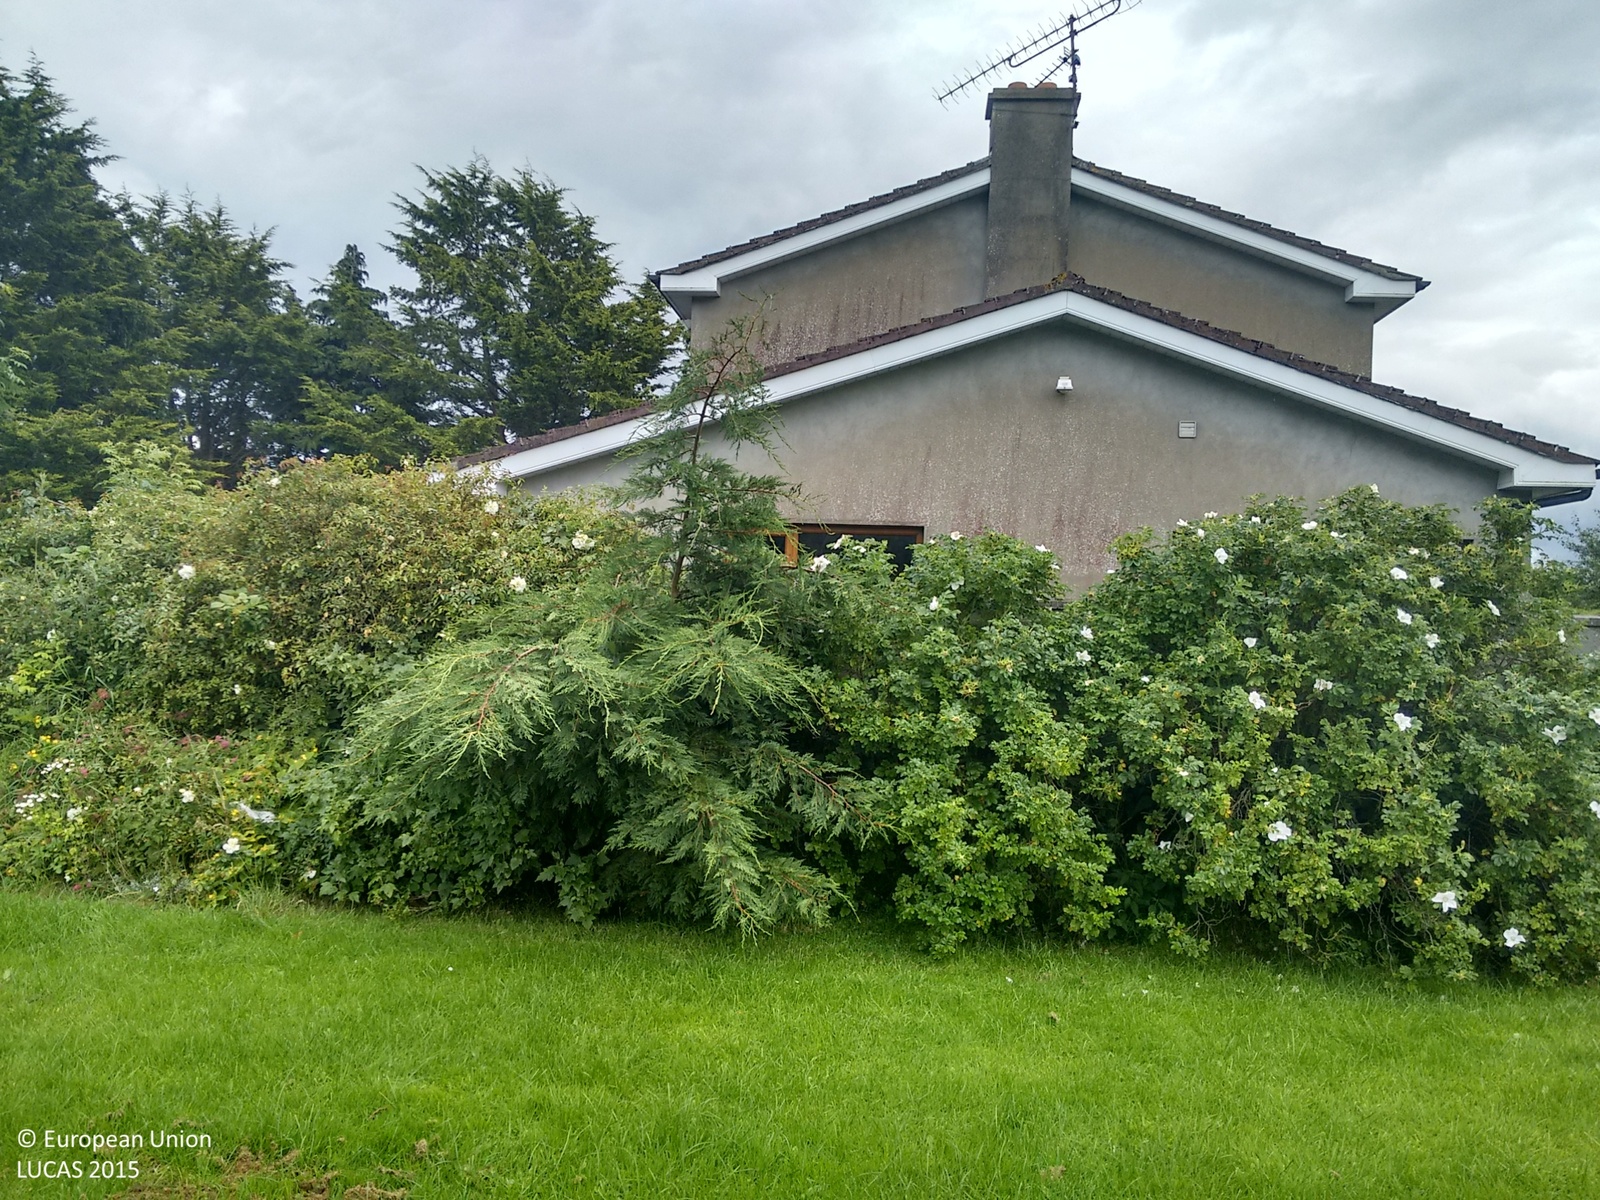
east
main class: Grassland
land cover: Grassland without tree/shrub cover
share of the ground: > 75 %
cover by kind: herbaceous plants 95 %, shrubs 5 %
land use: Residential
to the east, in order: Grassland without tree/shrub cover; Artificial constructions in urban areas; Rivers and streams; Managed hedges; Grassland without tree/shrub cover; Inland fresh running water; Grassland without tree/shrub cover; Managed hedges; Tracks; Managed hedges; Grassland without tree/shrub cover
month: July
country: IE
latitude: 53.7324
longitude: -7.7656
